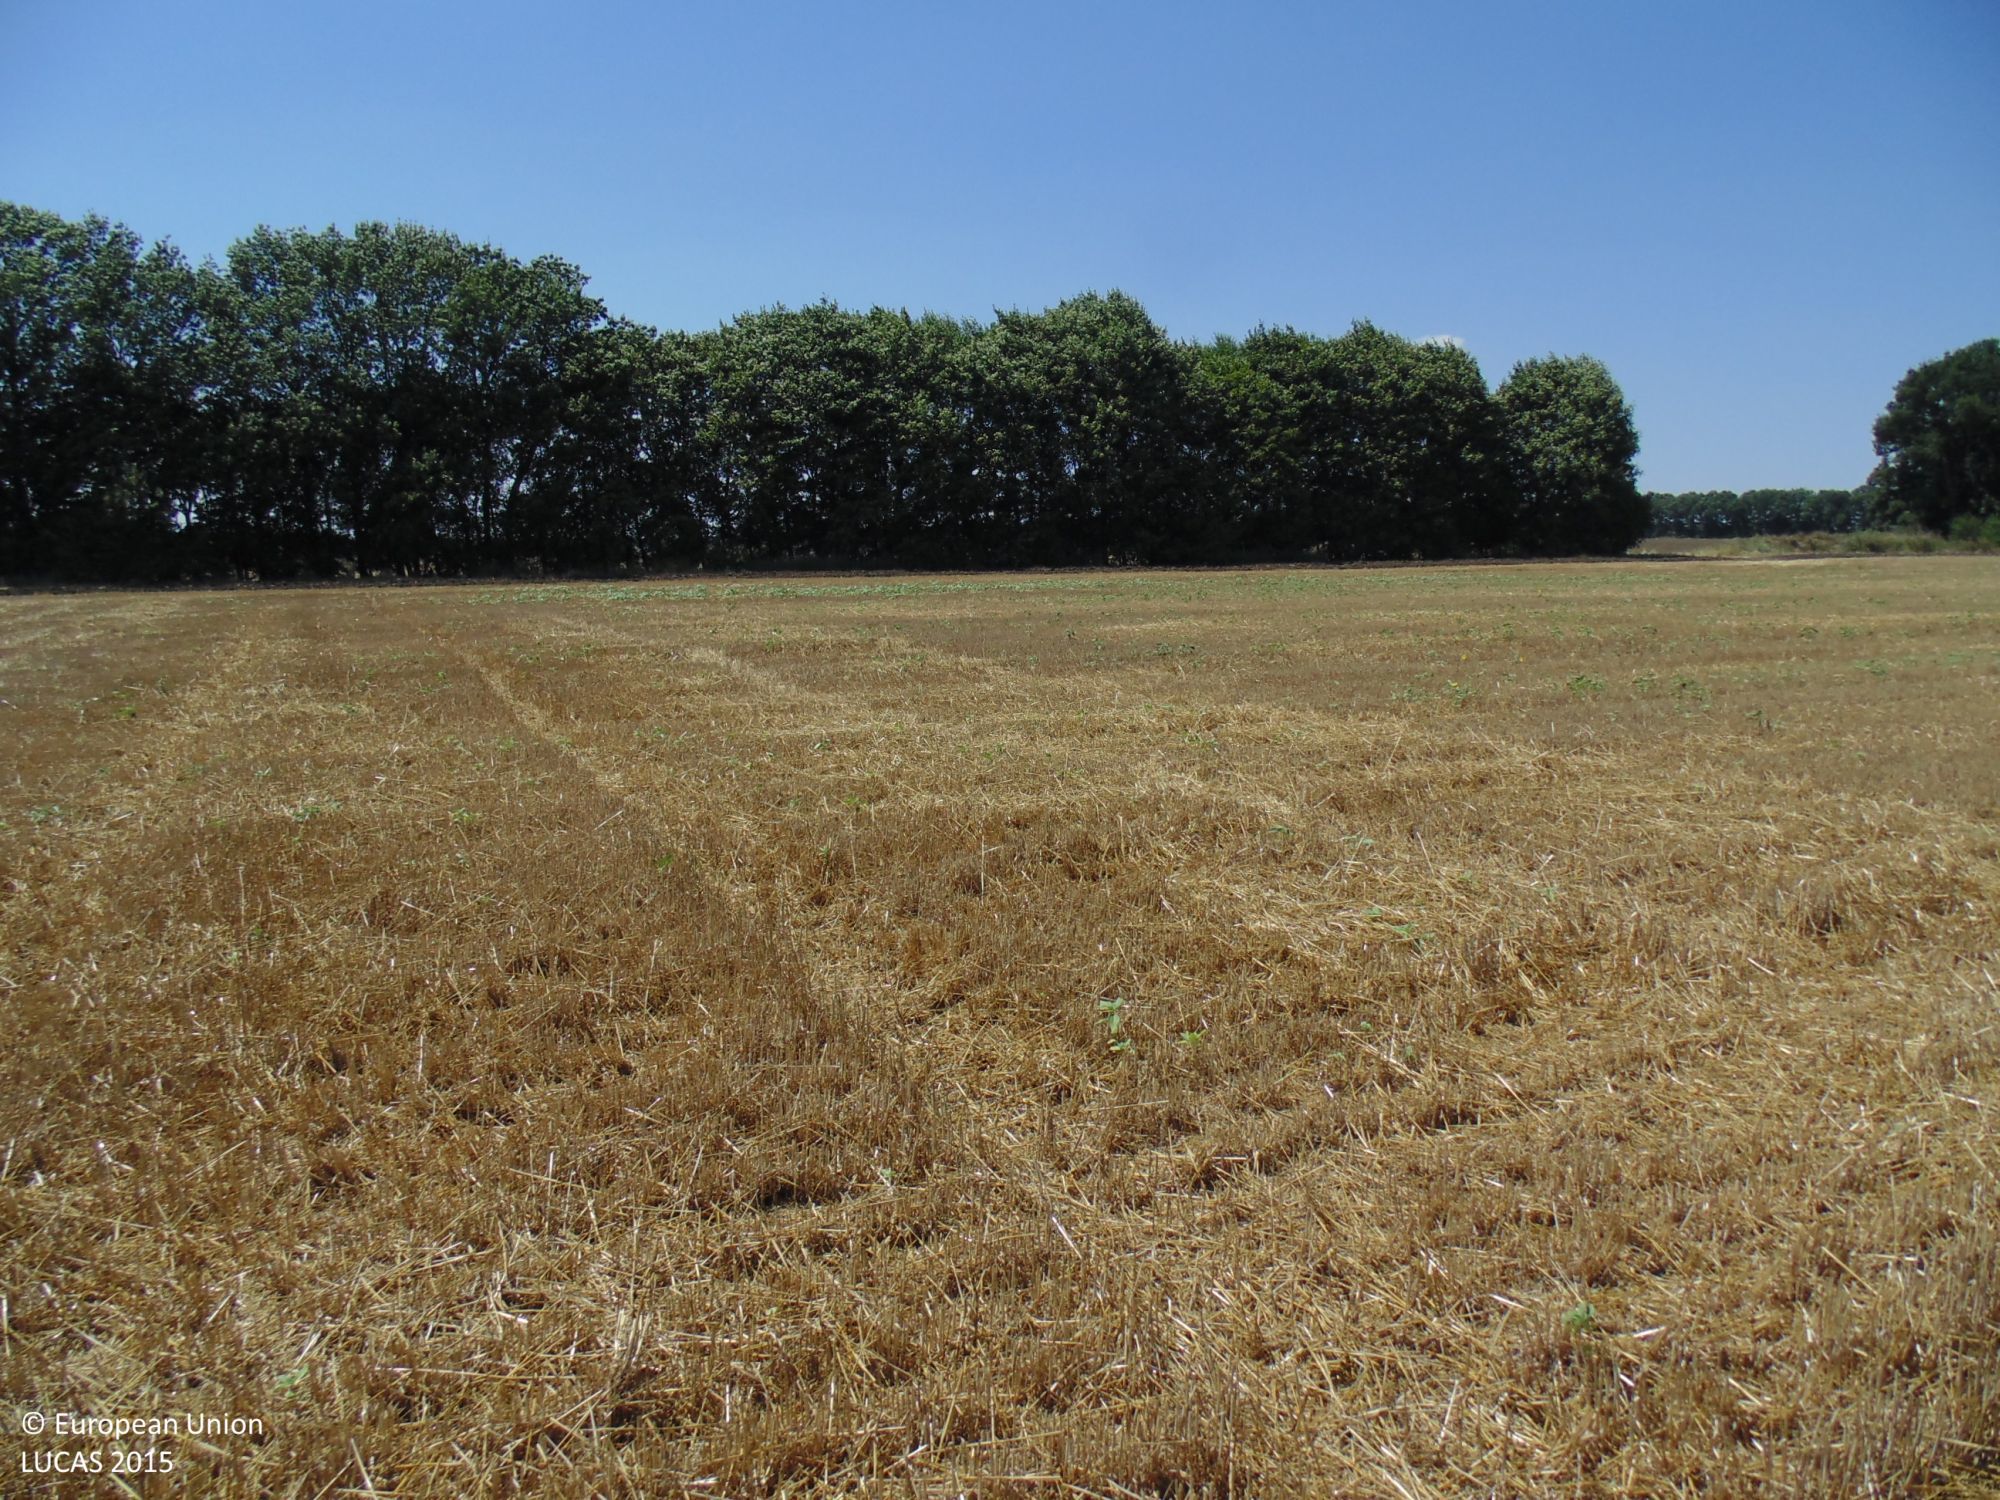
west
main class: Cropland
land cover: Common wheat
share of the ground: > 75 %
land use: Agriculture (excluding fallow land and kitchen gardens)
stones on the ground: < 10 %
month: August
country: BG
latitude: 43.5873
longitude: 28.1215
